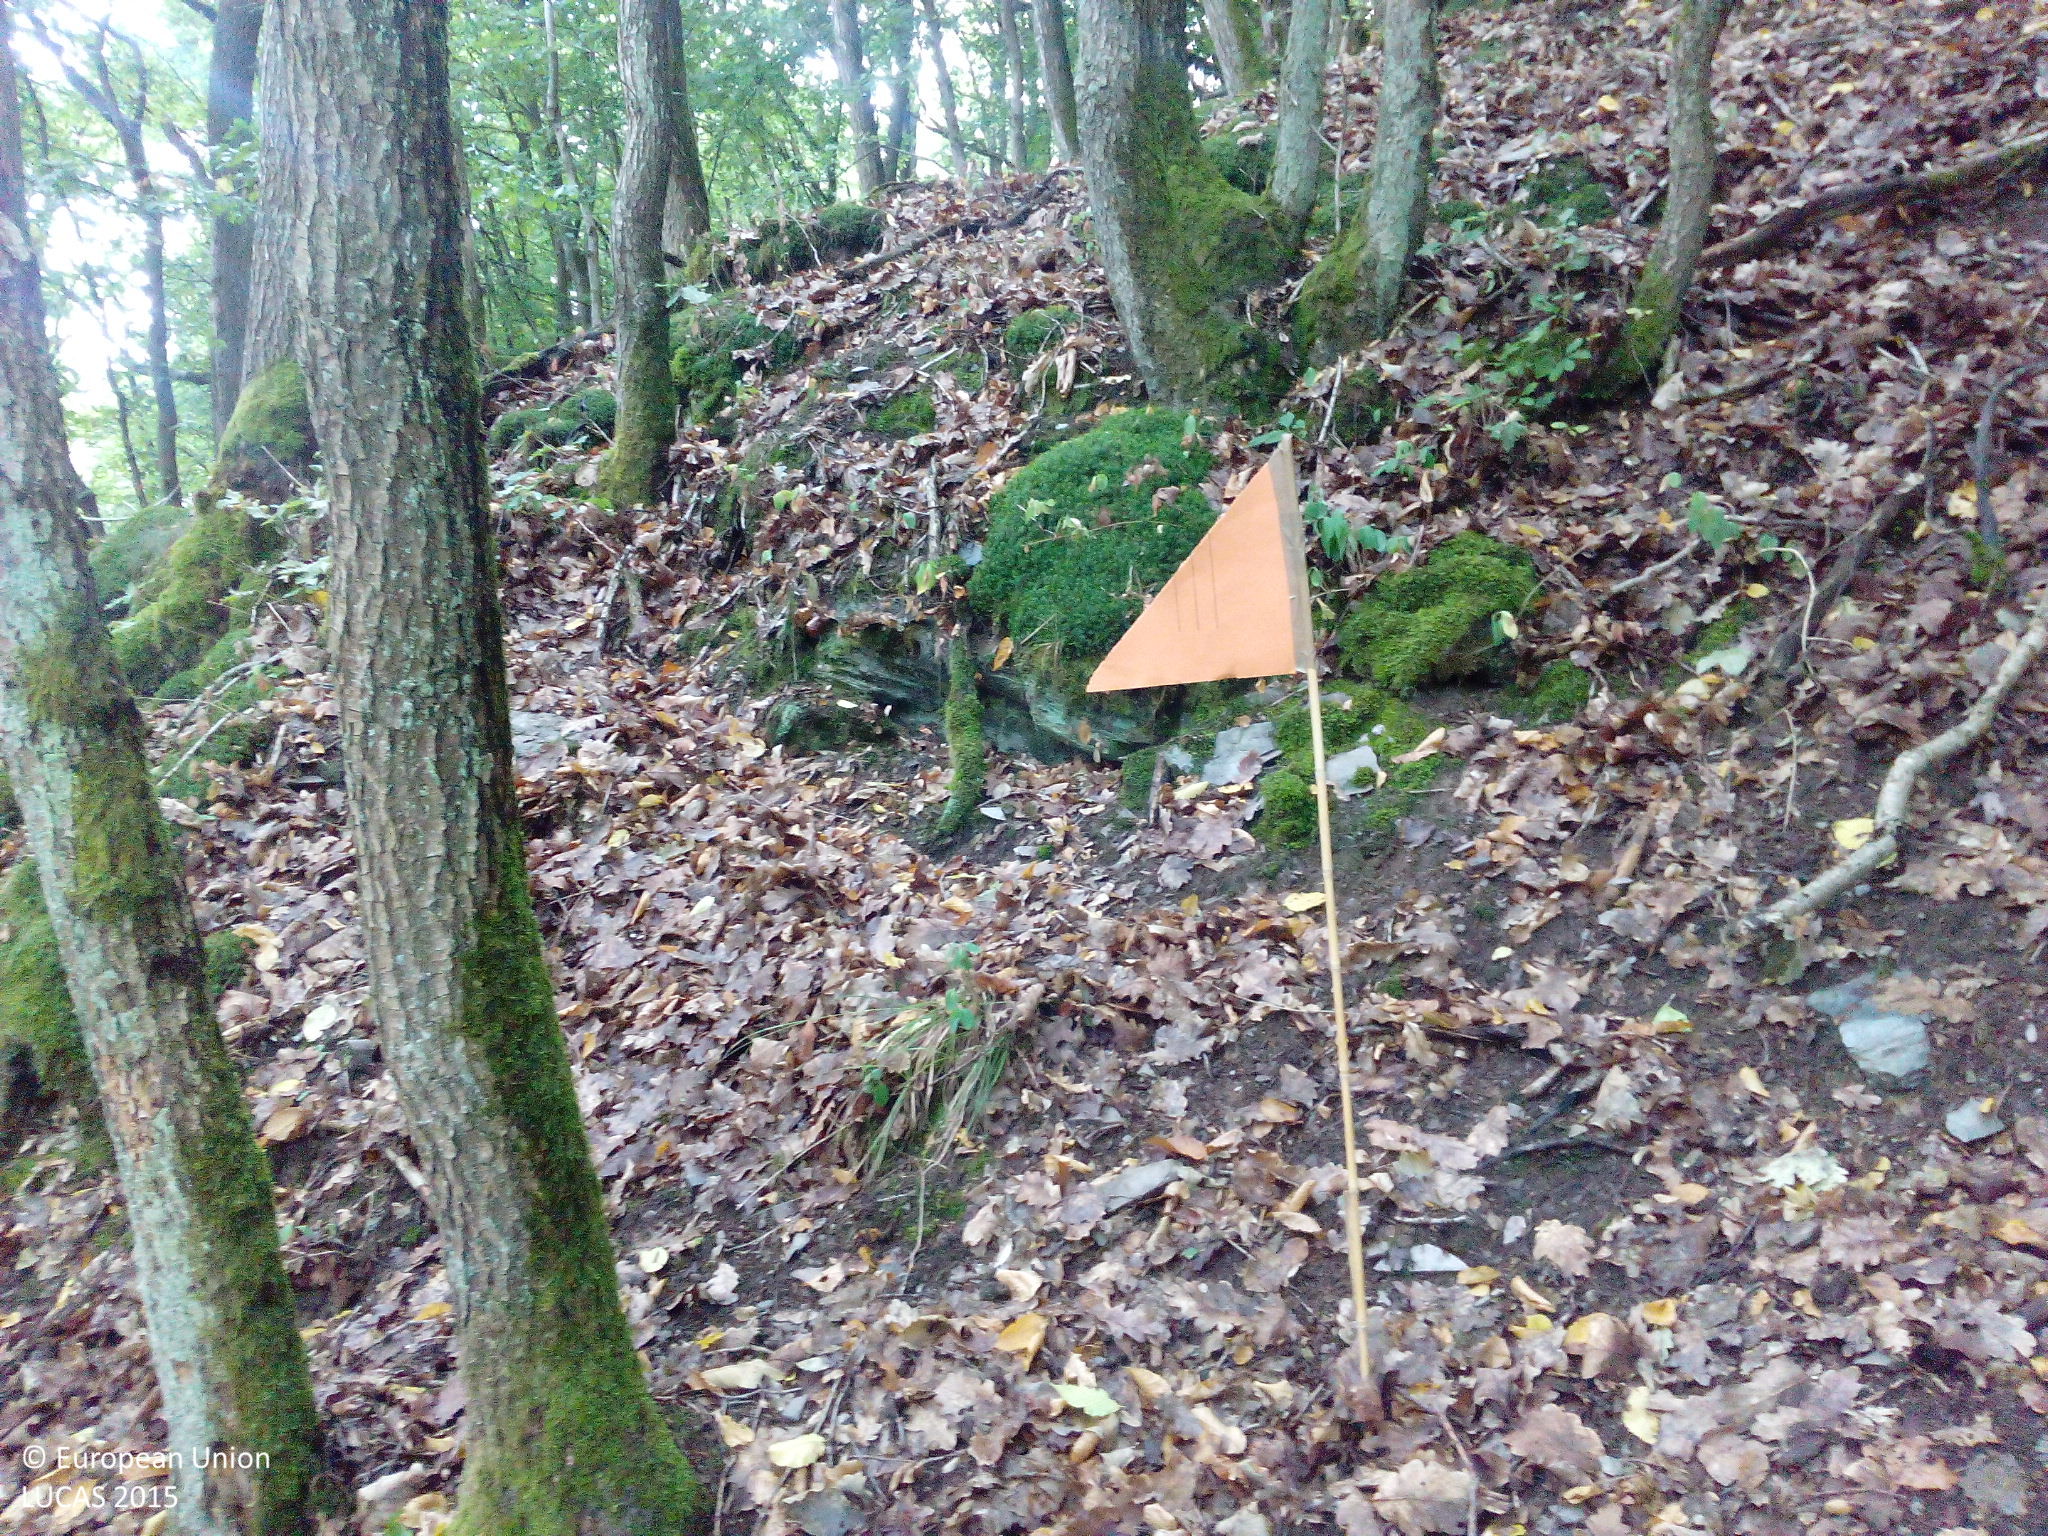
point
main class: Woodland
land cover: Broadleaved woodland
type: mesophytic deciduous forest
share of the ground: > 75 %
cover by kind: broadleaved forest trees 100 %
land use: Forestry
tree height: > 5 m
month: July
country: DE
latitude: 49.9858
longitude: 7.1131
